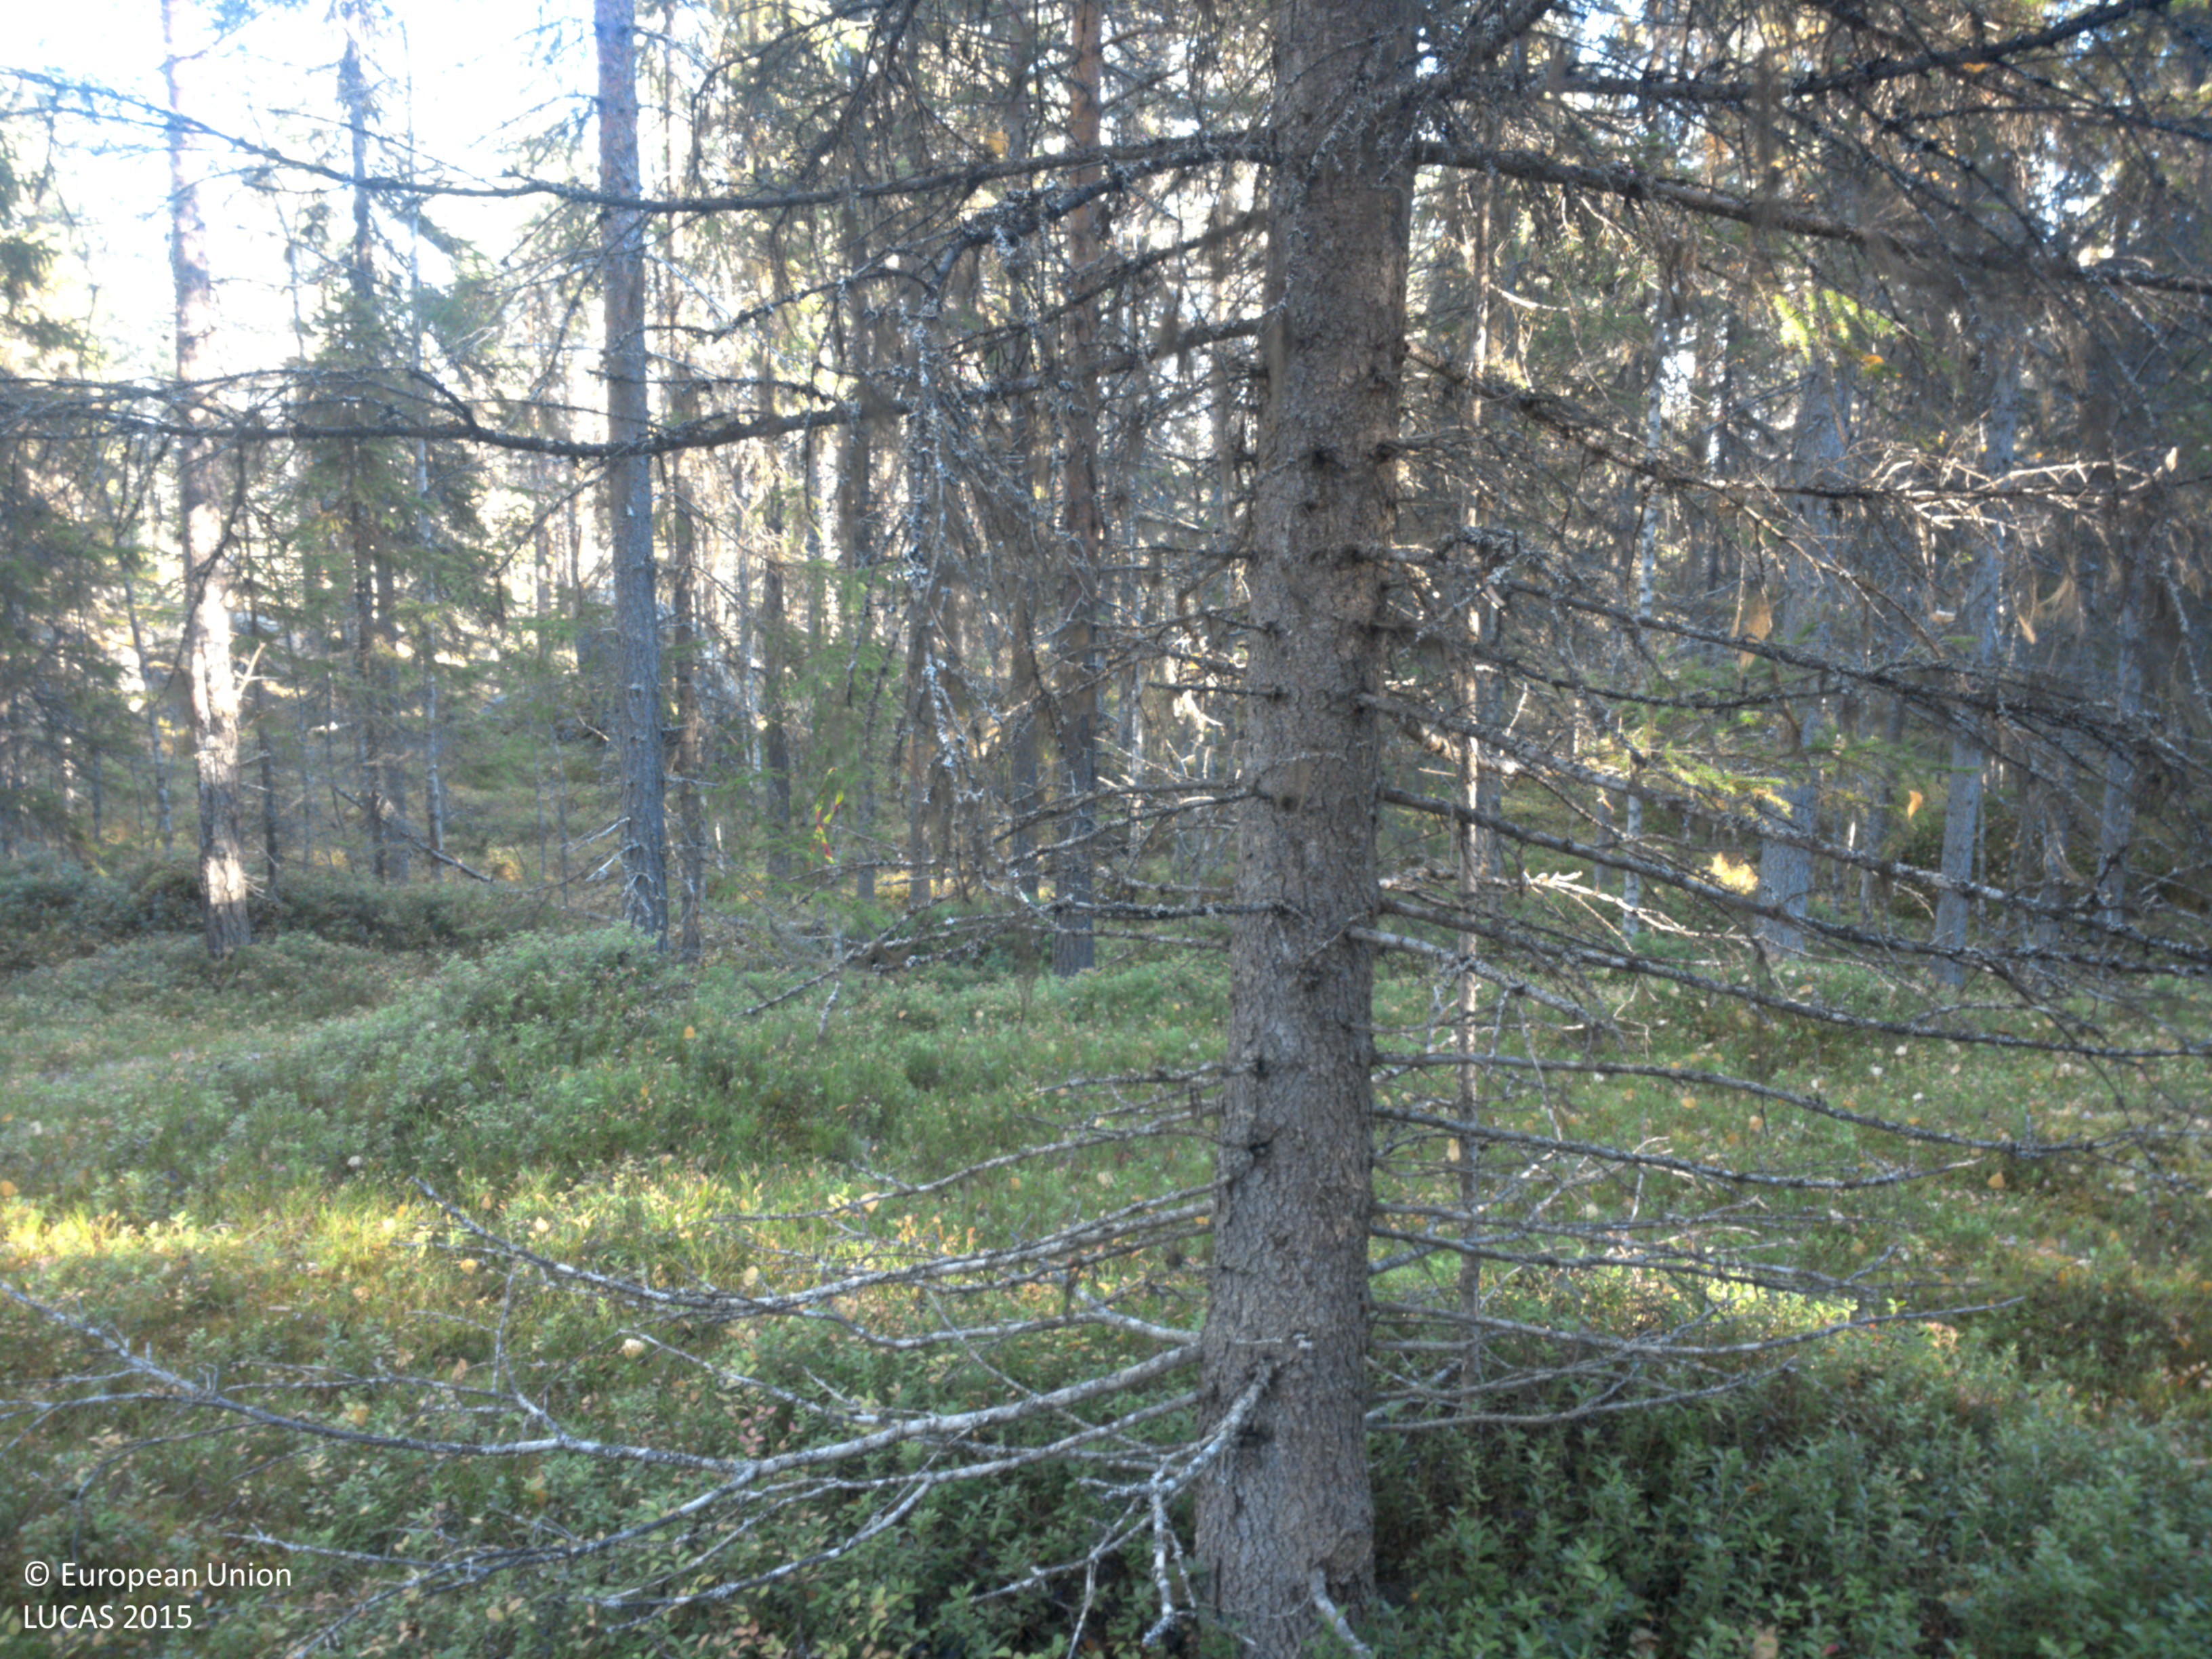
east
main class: Woodland
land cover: Other mixed woodland
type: boreal forest
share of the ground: > 75 %
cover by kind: coniferous forest trees 60 %, broadleaved forest trees 25 %, shrubs 10 %, lichens and mosses 5 %
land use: Forestry
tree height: > 5 m
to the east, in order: Other mixed woodland; Pine dominated mixed woodland; Pine dominated coniferous woodland; Pine dominated mixed woodland; Spruce dominated mixed woodland; Ditches and canals; Paved roads, cycling and walking lanes; Shruby margins; Pine dominated coniferous woodland; Pine dominated mixed woodland; Pine dominated coniferous woodland; Spruce dominated mixed woodland
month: October
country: SE
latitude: 64.7776
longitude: 18.3576
